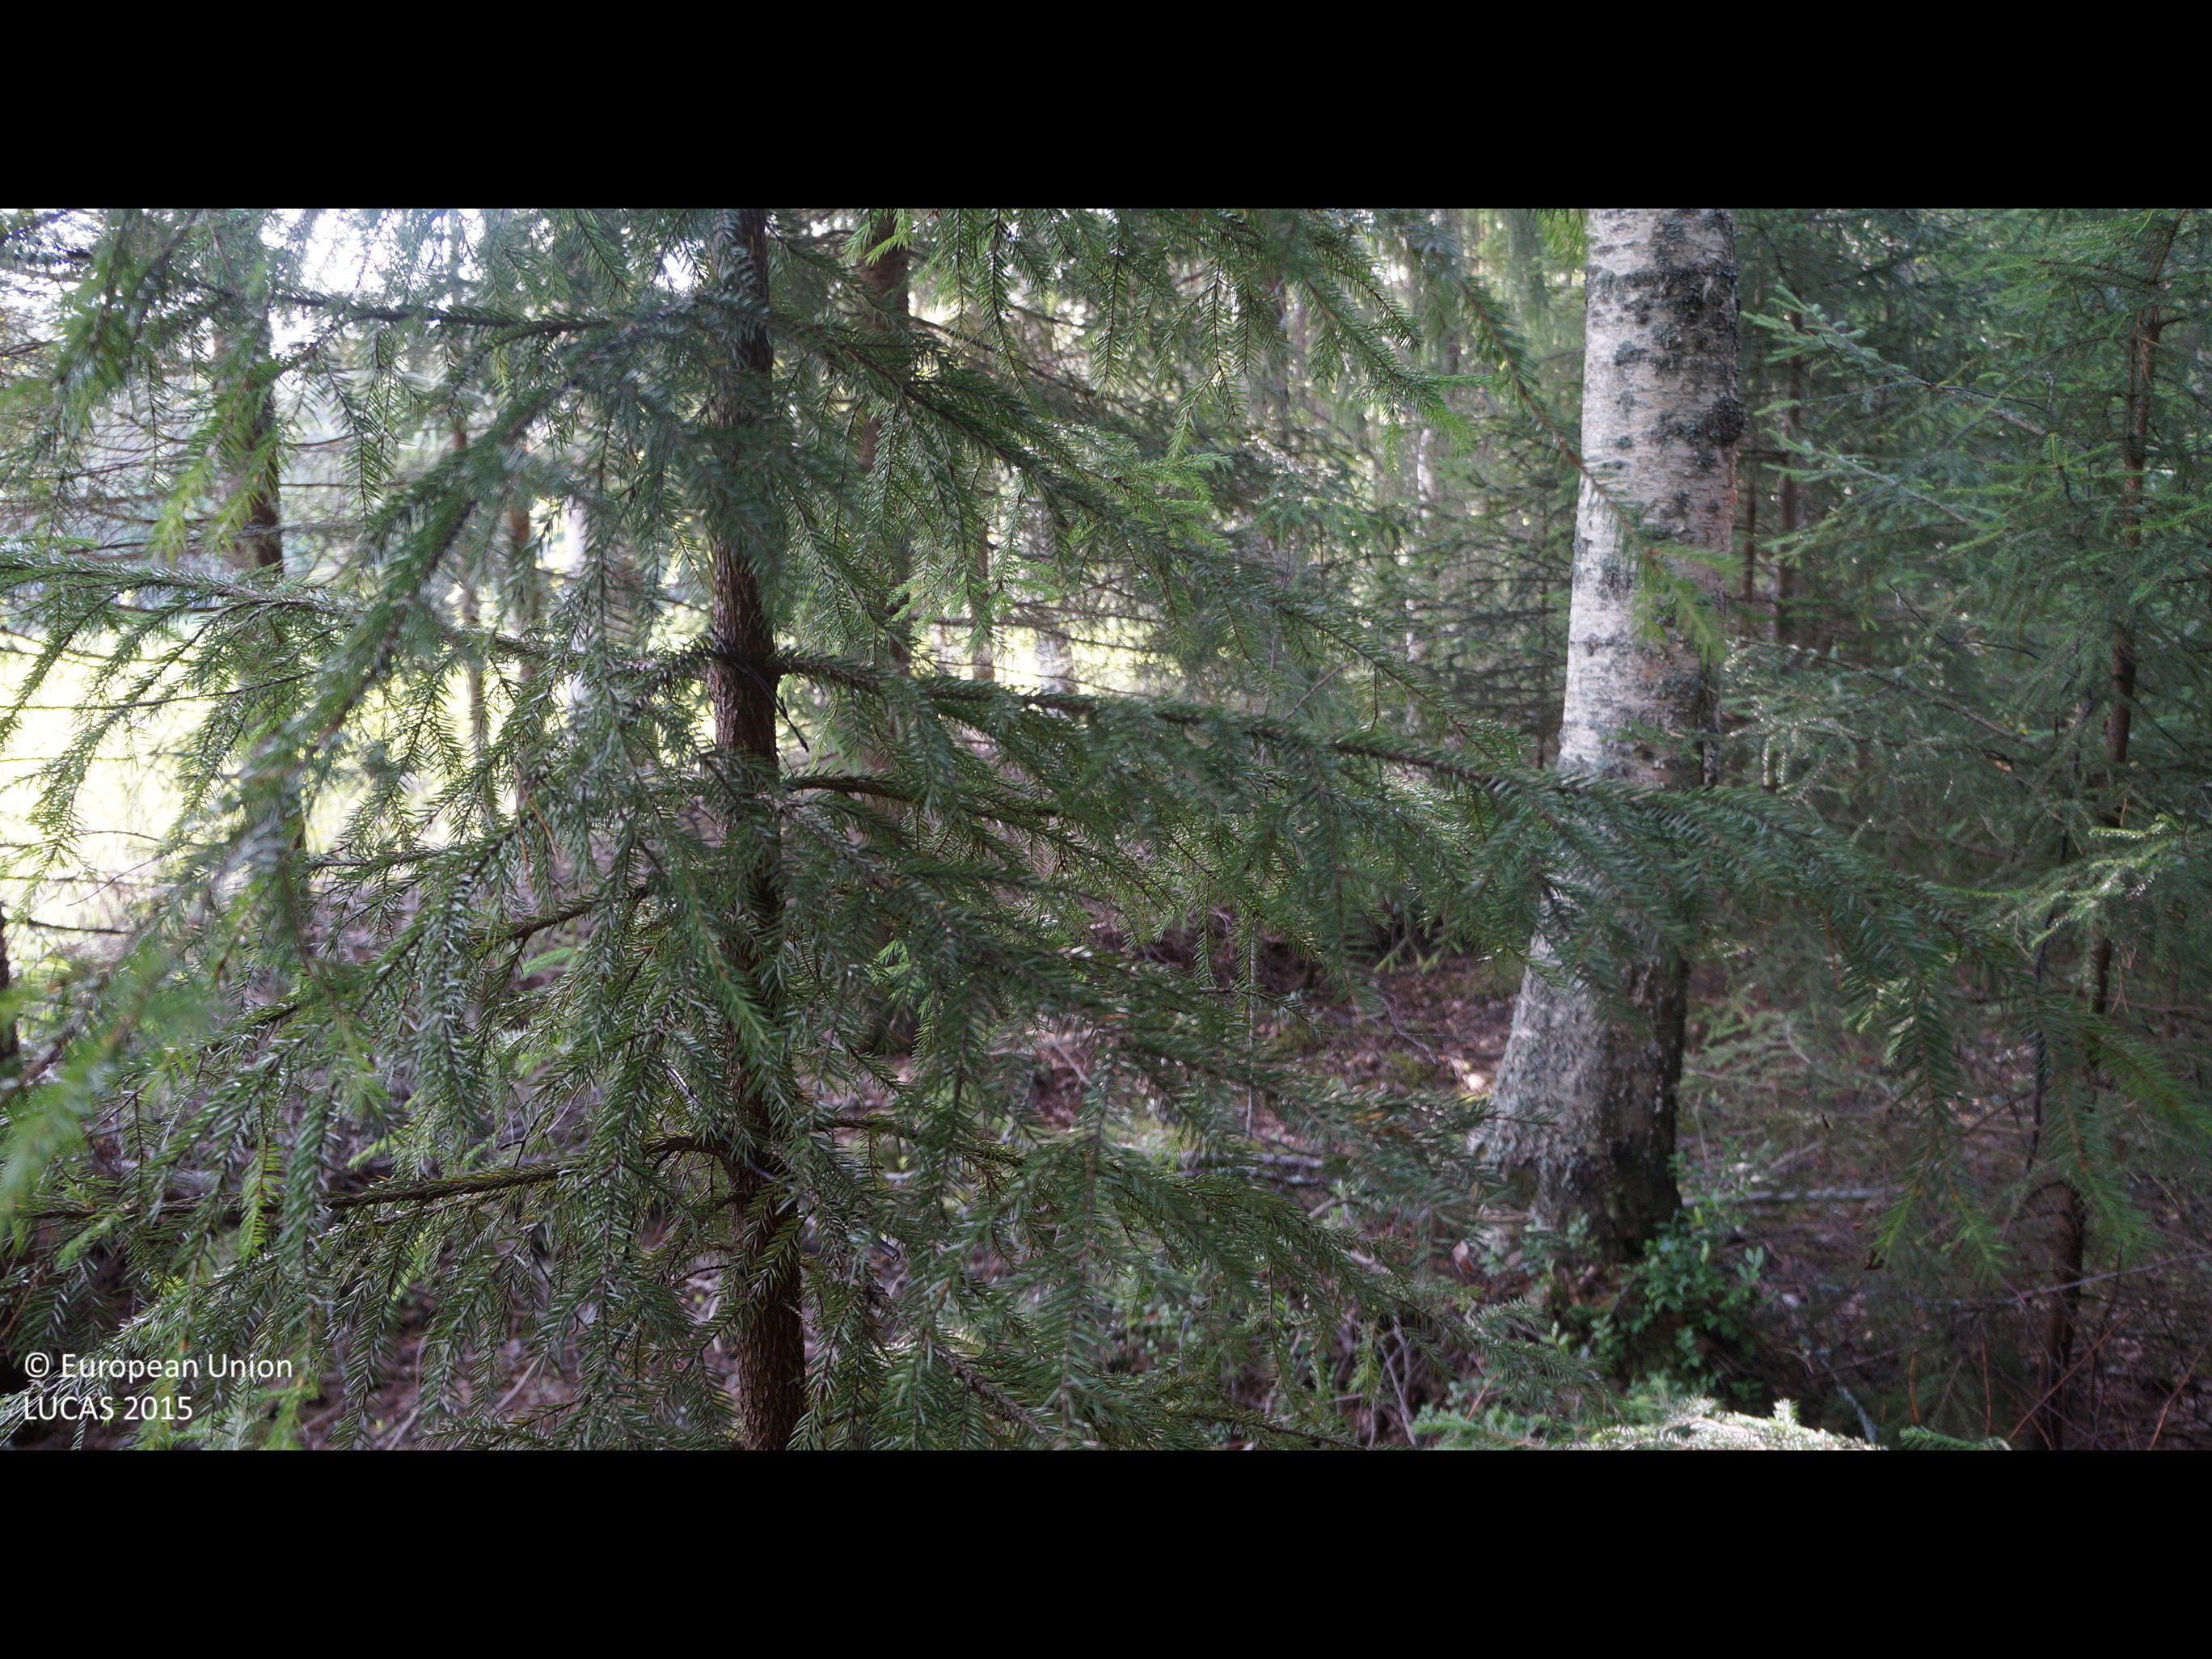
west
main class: Woodland
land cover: Spruce dominated mixed woodland
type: boreal forest
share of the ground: > 75 %
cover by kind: coniferous forest trees 50 %, broadleaved forest trees 35 %, shrubs 10 %, lichens and mosses 5 %
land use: Forestry
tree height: > 5 m
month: July
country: FI
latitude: 64.6488
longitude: 24.7031
